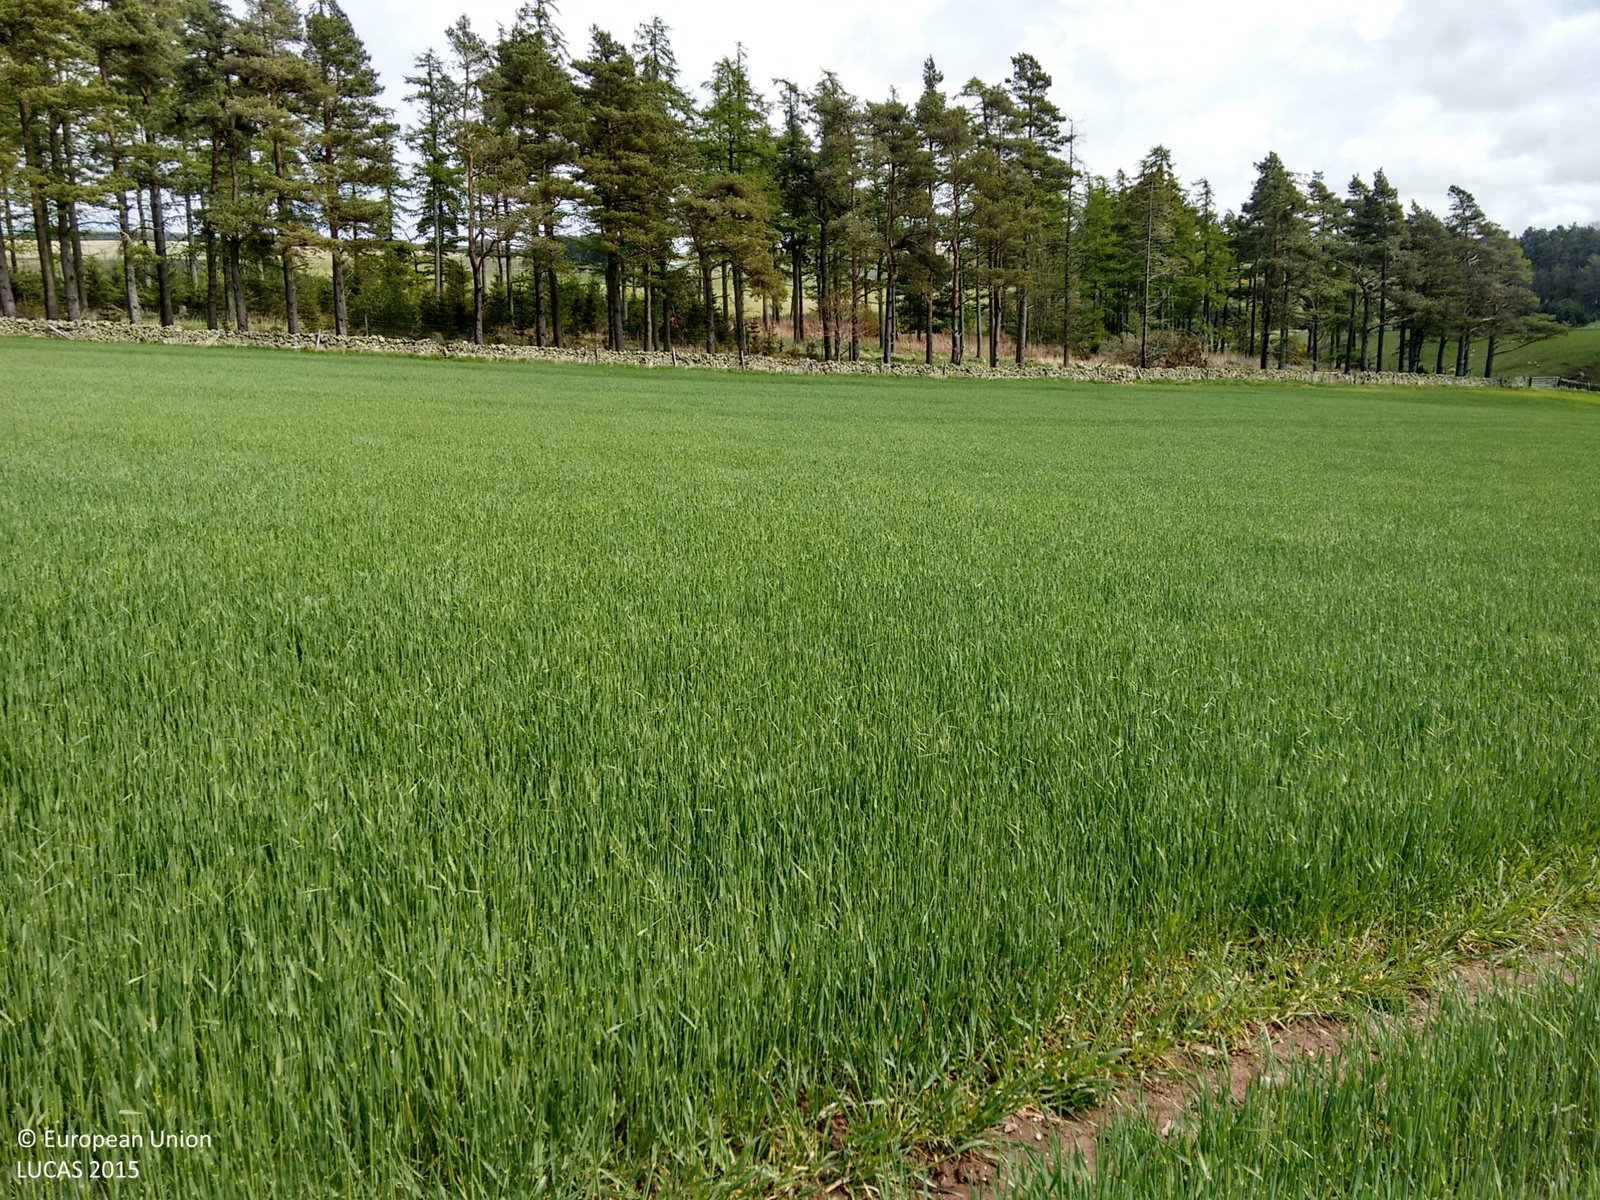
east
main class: Cropland
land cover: Barley
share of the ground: > 75 %
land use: Agriculture (excluding fallow land and kitchen gardens)
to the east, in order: Barley; Grass margins; Dry stone walls; Other mixed woodland; Fences; Other bare soil; Barley
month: May
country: GB
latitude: 55.8466
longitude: -2.5016
